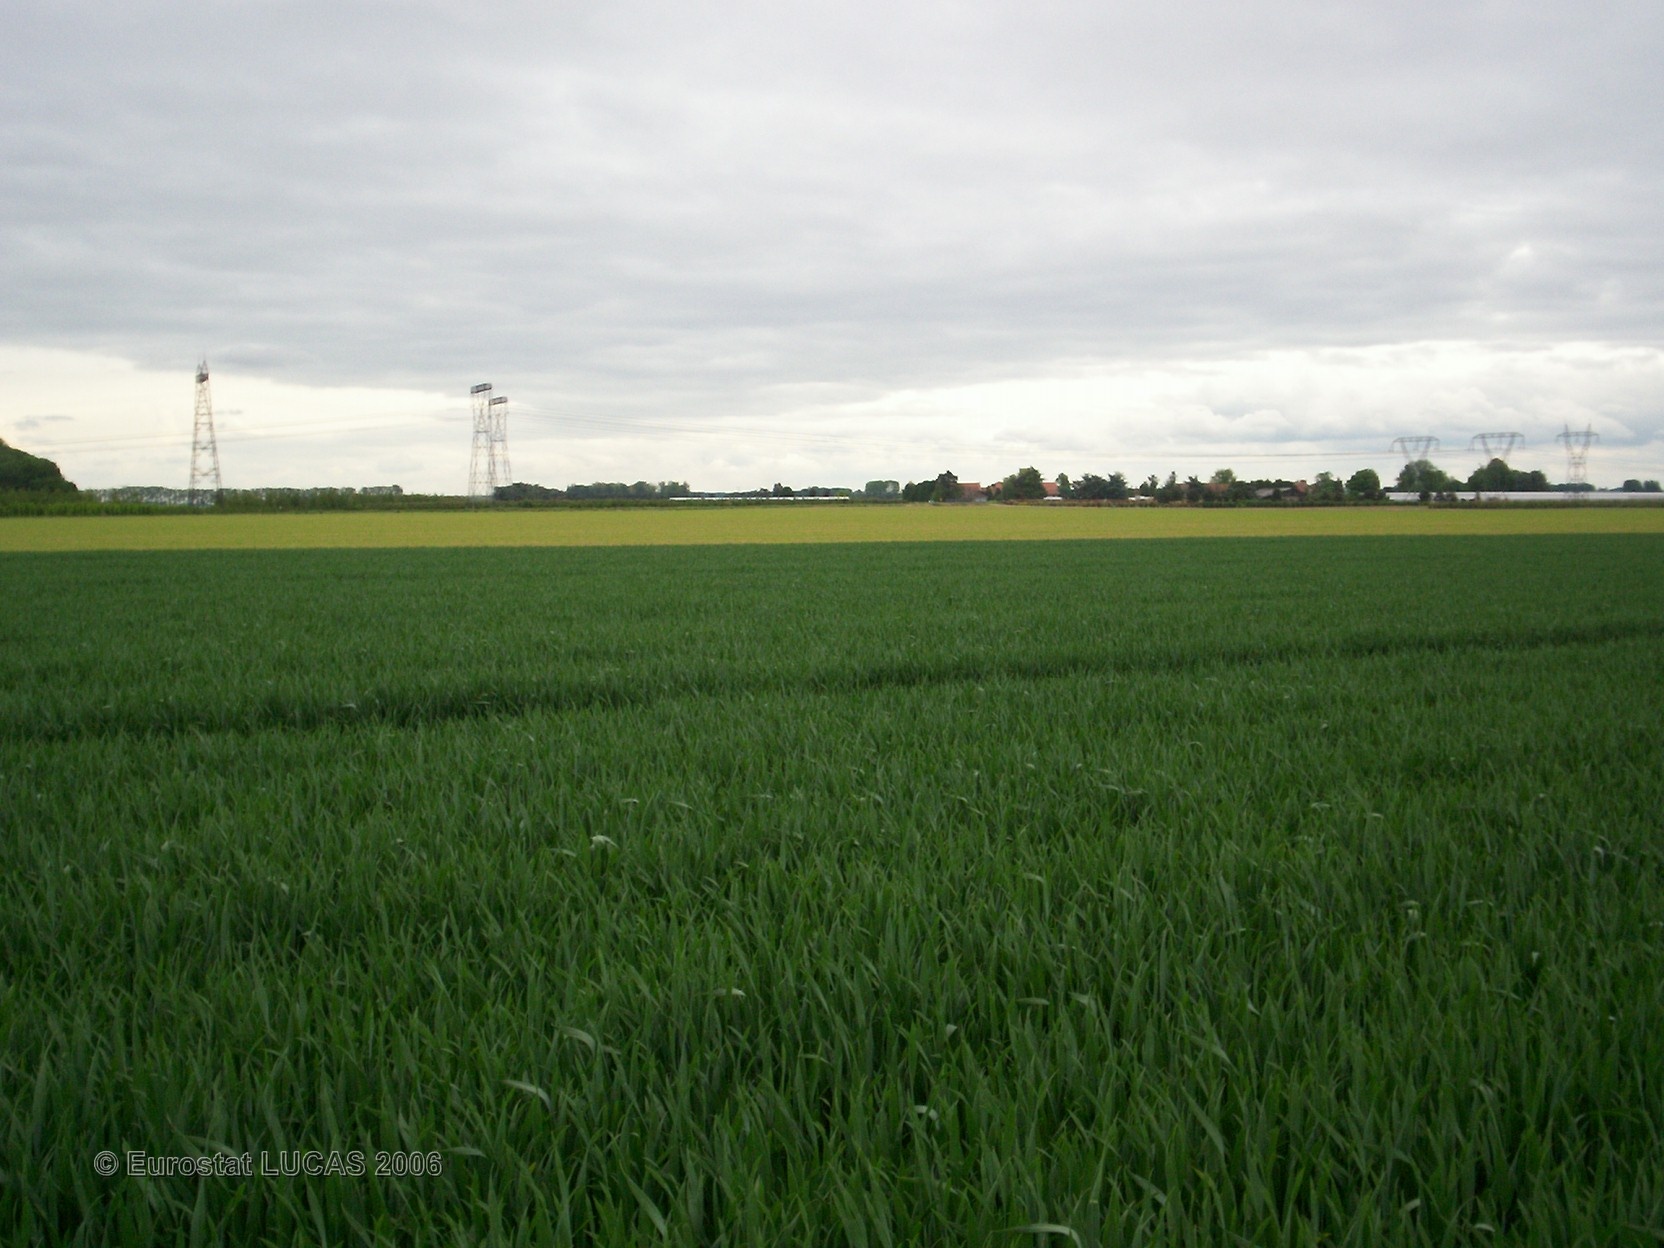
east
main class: Cropland
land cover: Common wheat
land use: Agriculture (excluding fallow land and kitchen gardens)
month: May
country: FR
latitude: 48.6159
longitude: 2.7333
